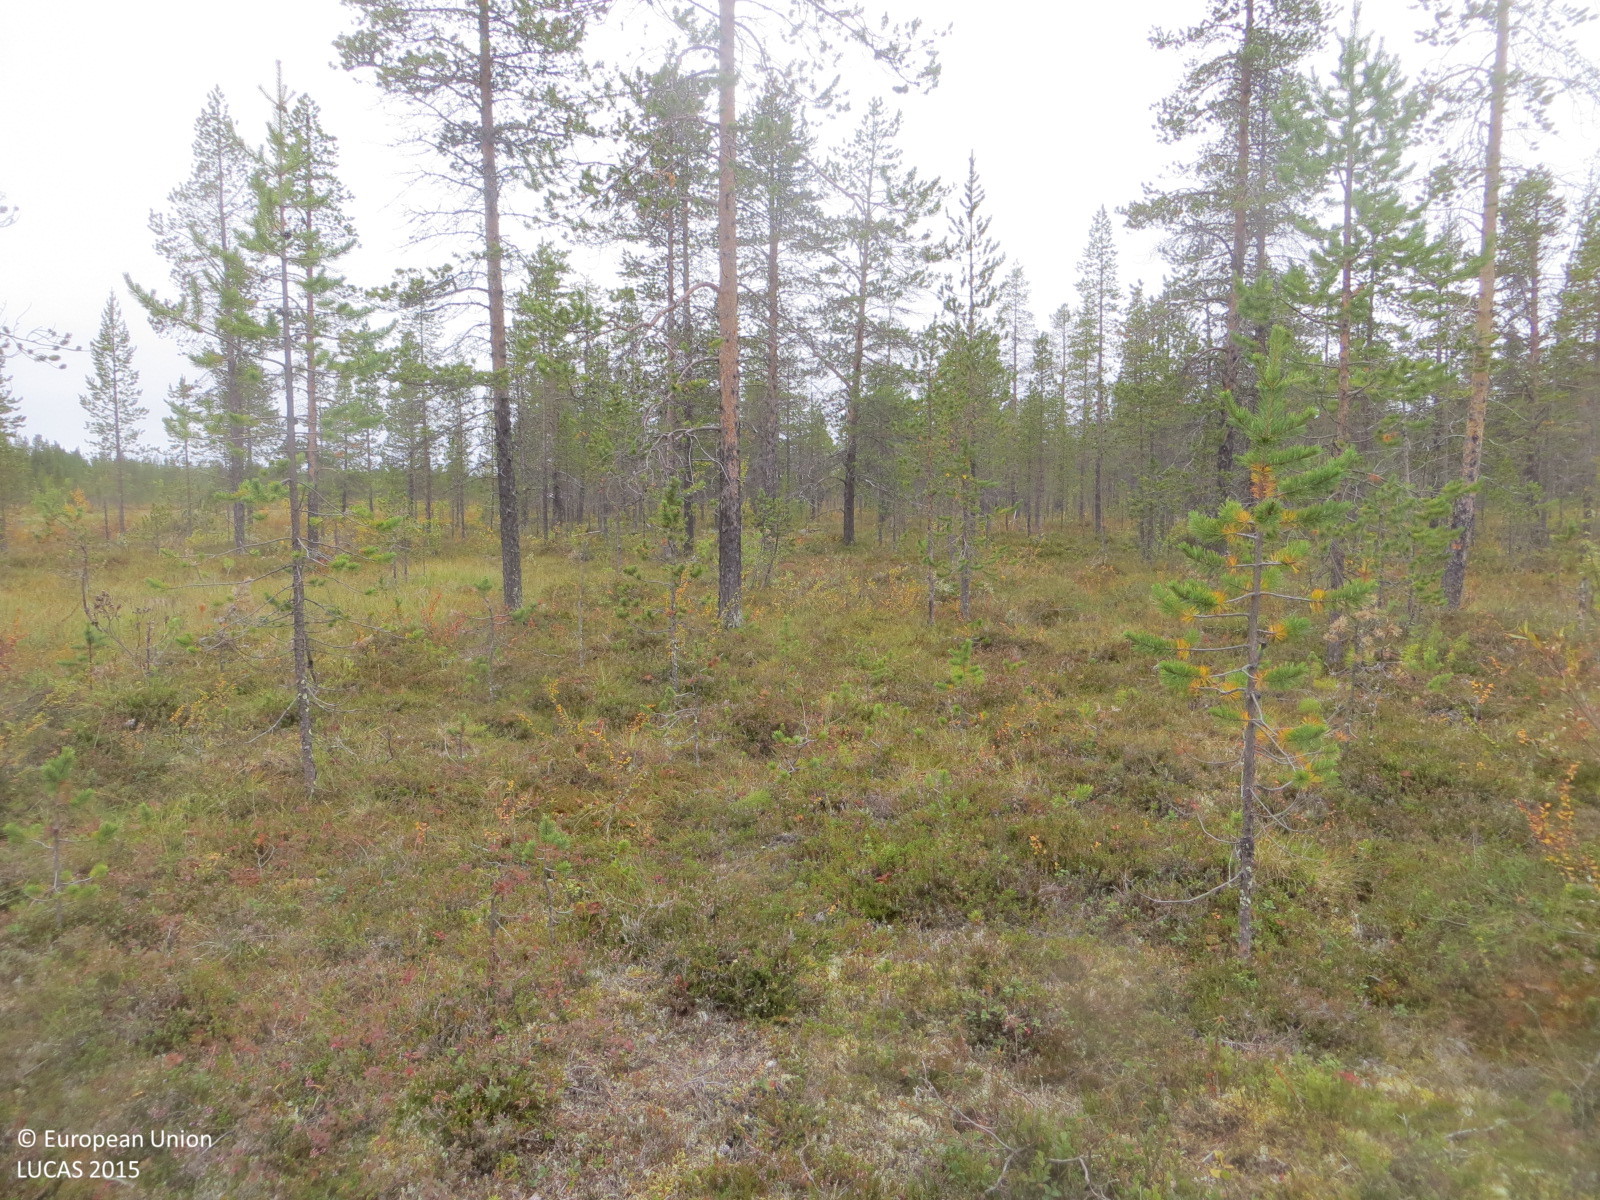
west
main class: Woodland
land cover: Pine dominated coniferous woodland
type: mire and swamp forests
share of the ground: 50 - 75 %
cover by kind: coniferous forest trees 55 %, shrubs 45 %
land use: Forestry
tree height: > 5 m
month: September
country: FI
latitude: 68.3366
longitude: 22.9360
